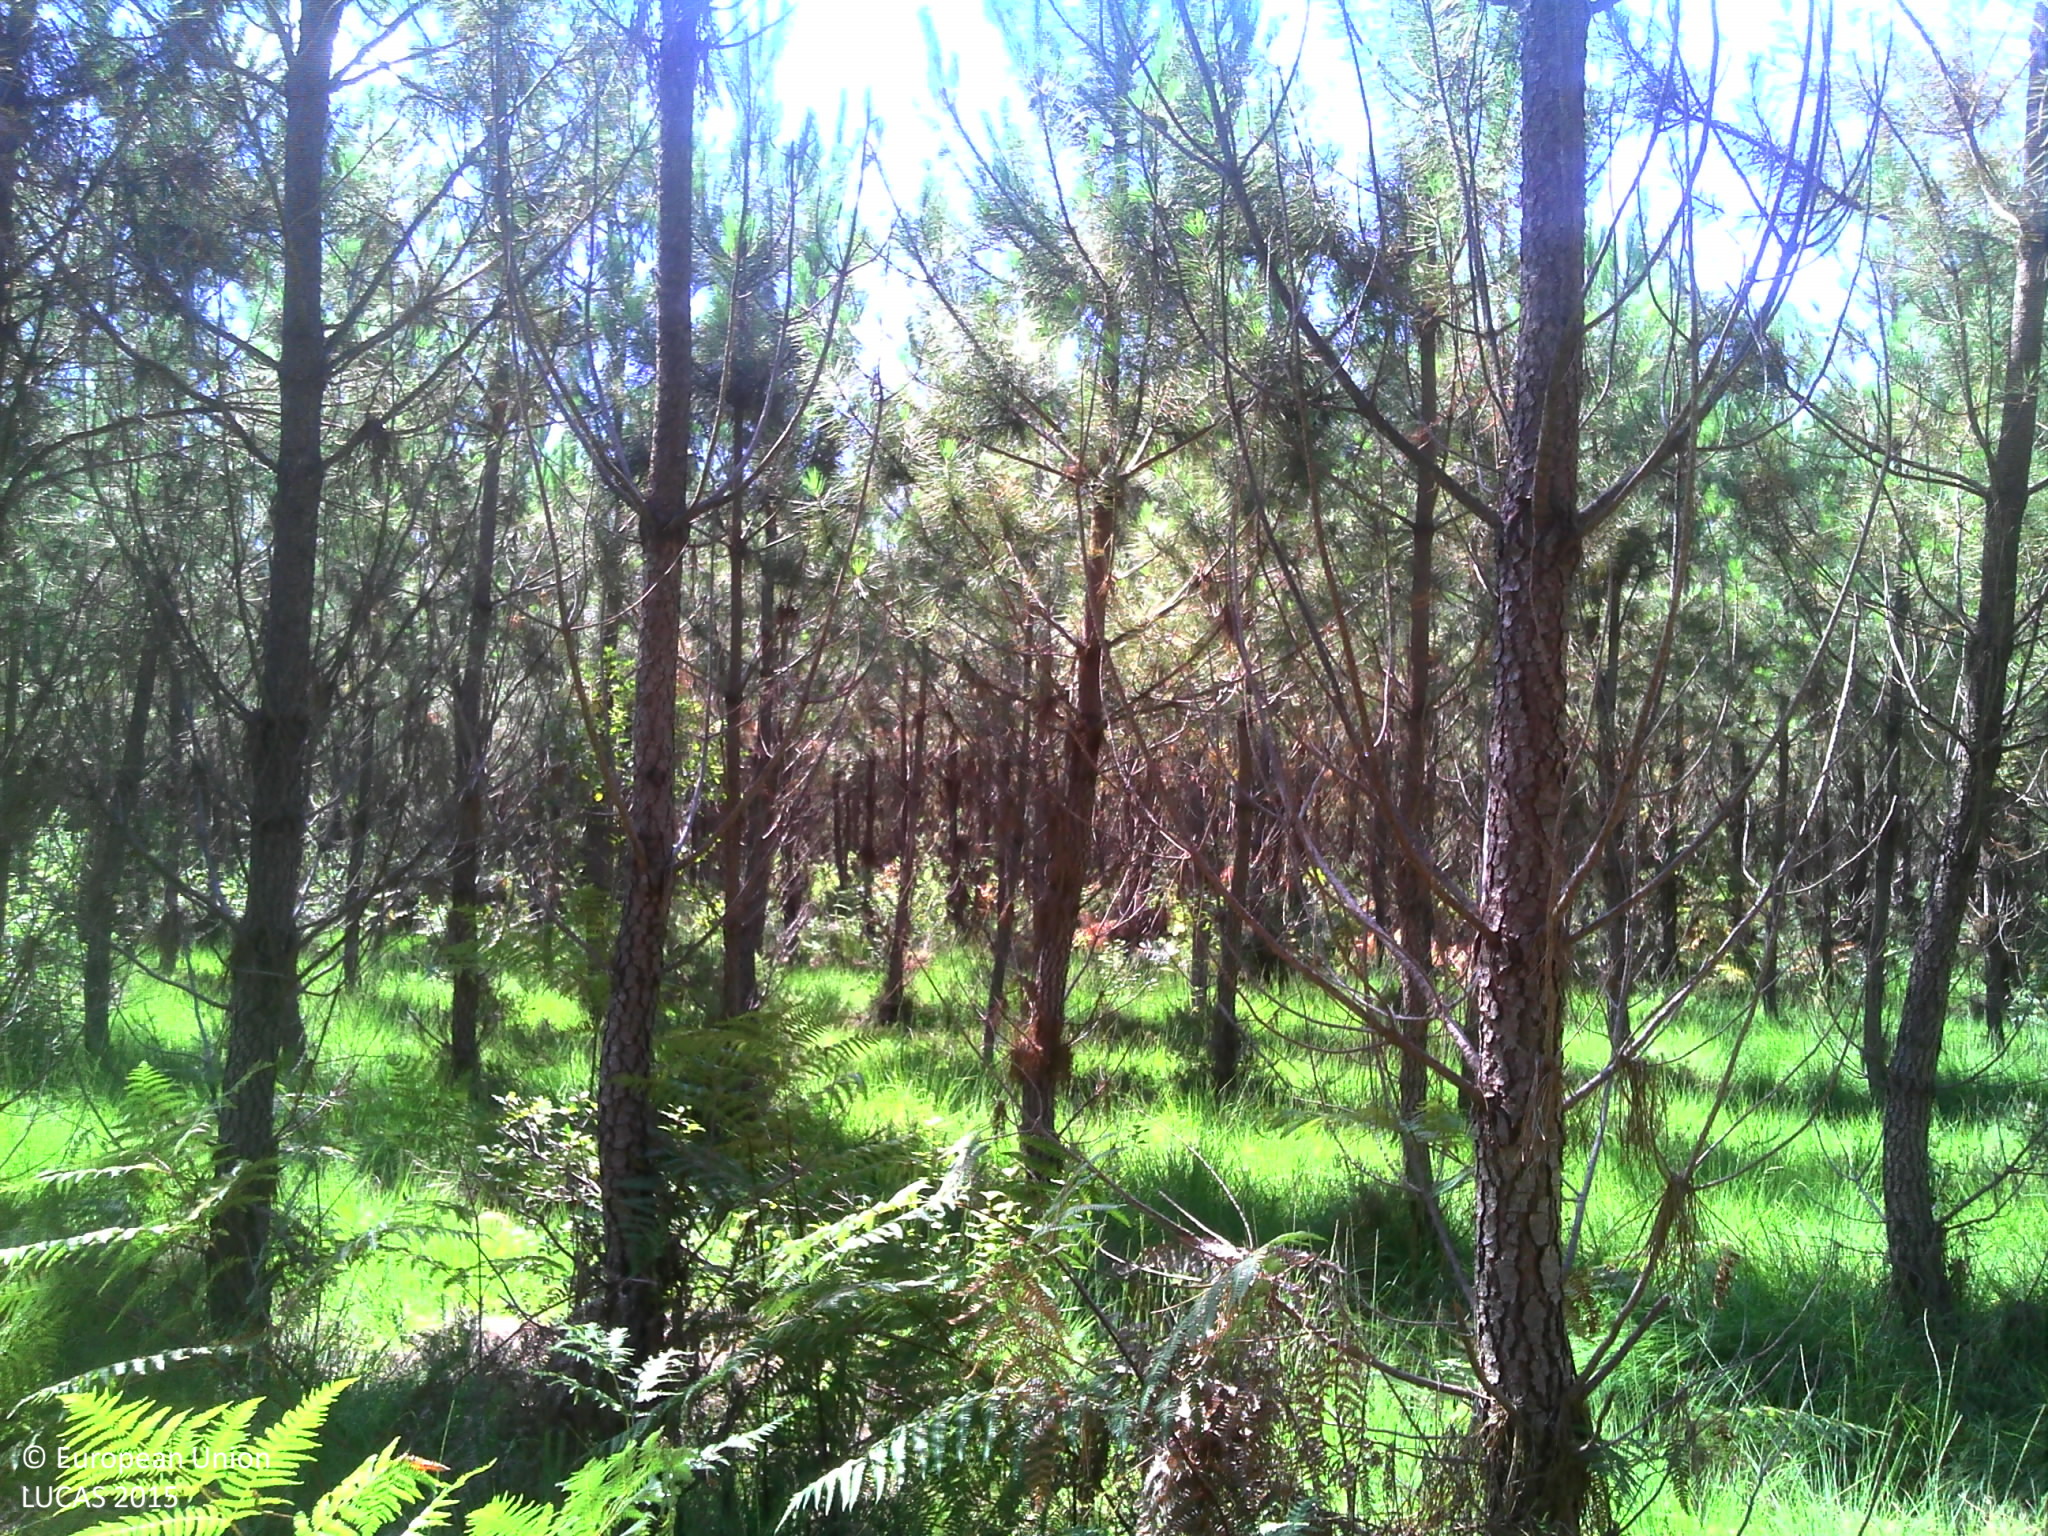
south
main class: Woodland
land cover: Pine dominated coniferous woodland
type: coniferous forest of the mediterranean region
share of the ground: > 75 %
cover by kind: coniferous forest trees 80 %, herbaceous plants 20 %
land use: Forestry
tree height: > 5 m
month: July
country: FR
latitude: 43.9320
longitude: -0.6137
